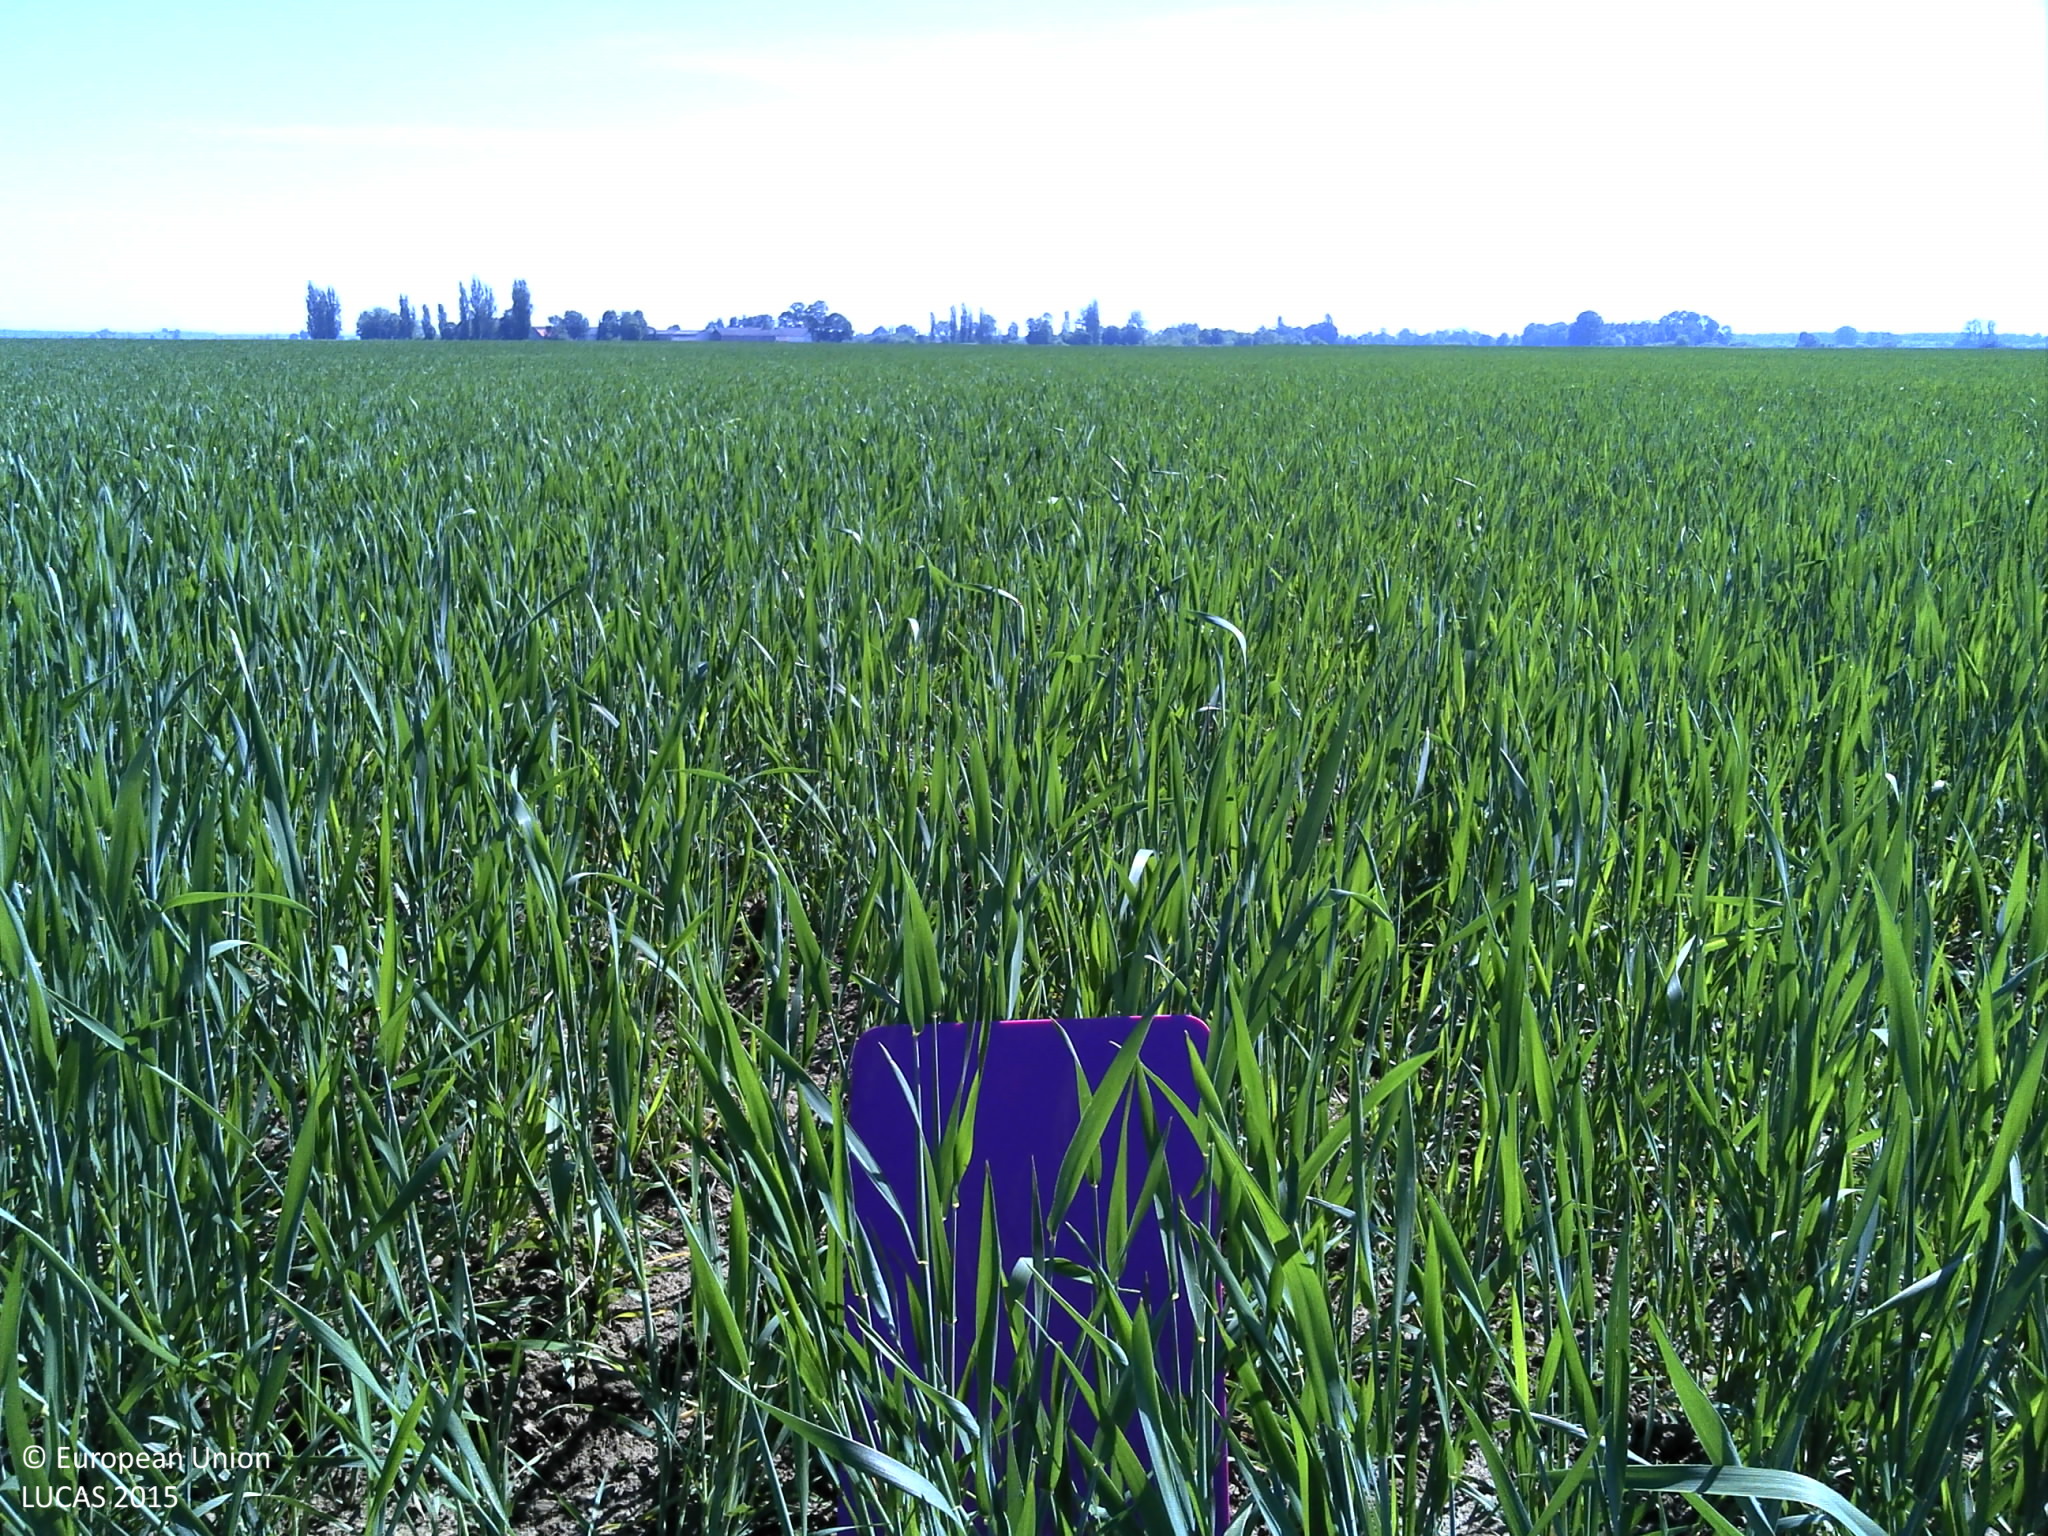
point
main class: Cropland
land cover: Common wheat
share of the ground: > 75 %
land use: Agriculture (excluding fallow land and kitchen gardens)
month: May
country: HR
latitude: 45.5994
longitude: 17.9911
